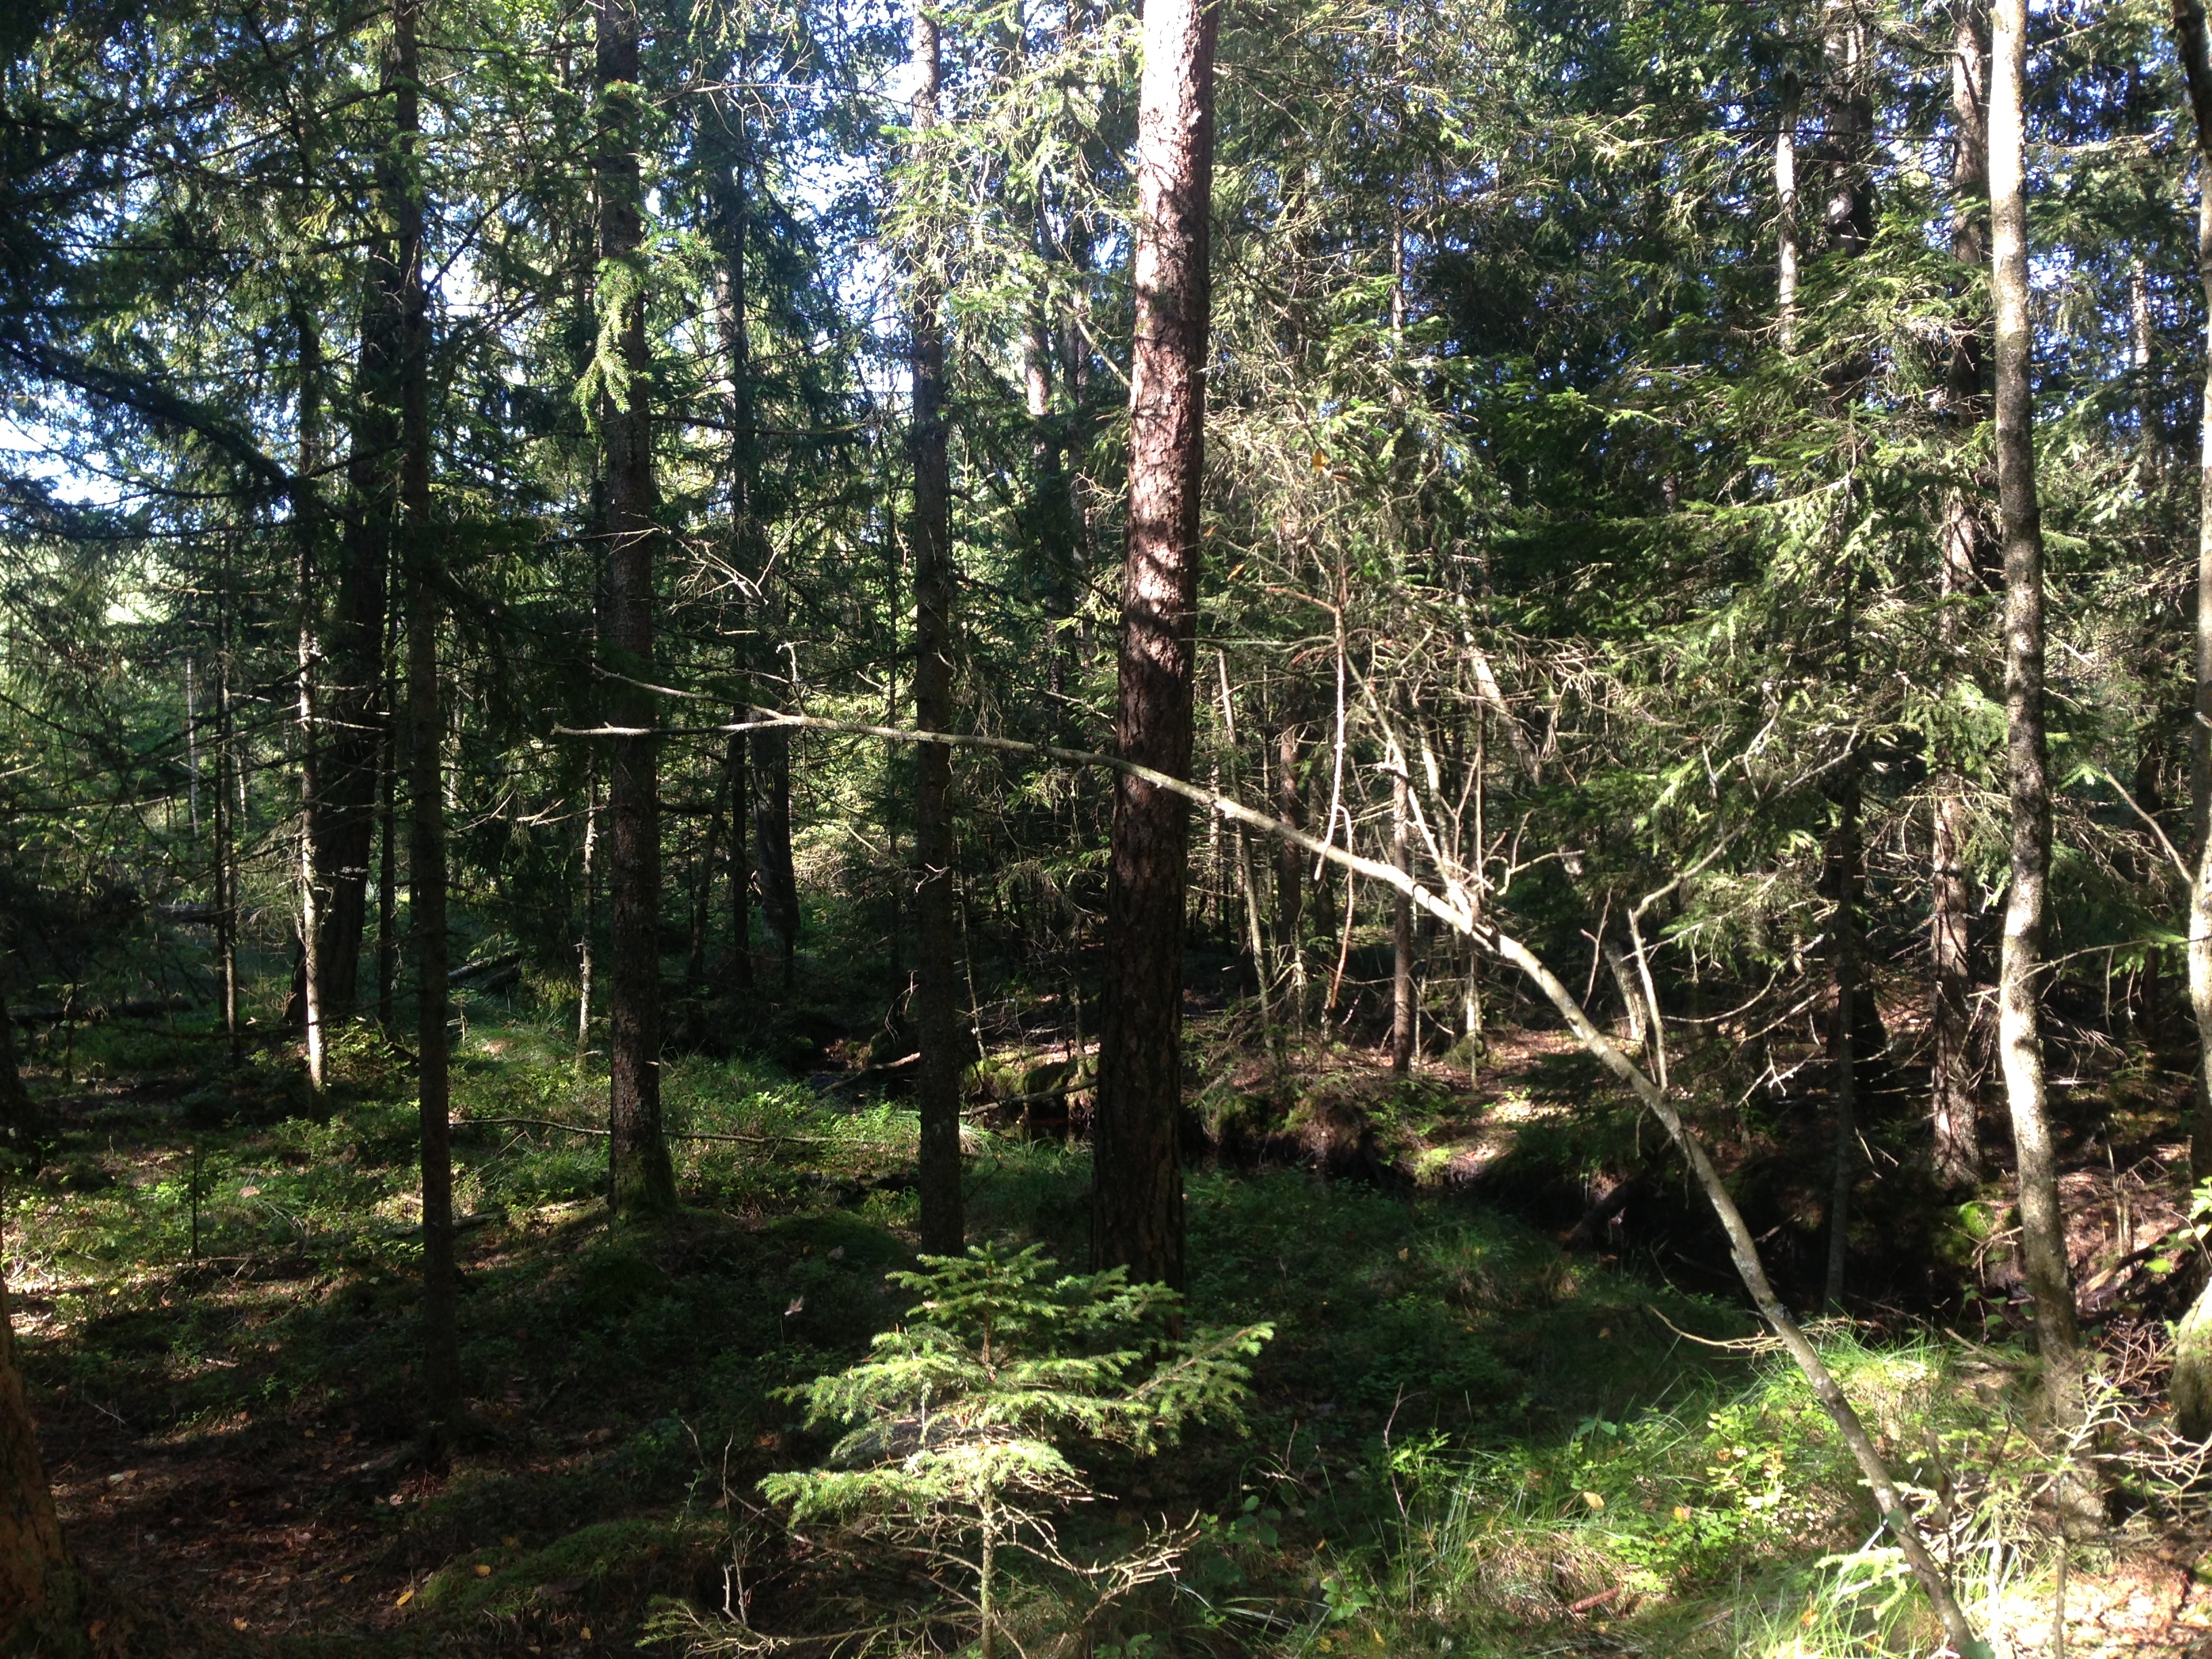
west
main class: Woodland
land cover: Pine dominated mixed woodland
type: boreal forest
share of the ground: > 75 %
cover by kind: coniferous forest trees 50 %, broadleaved forest trees 30 %, shrubs 20 %
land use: Forestry
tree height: > 5 m
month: September
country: SE
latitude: 57.1183
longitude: 13.2497
